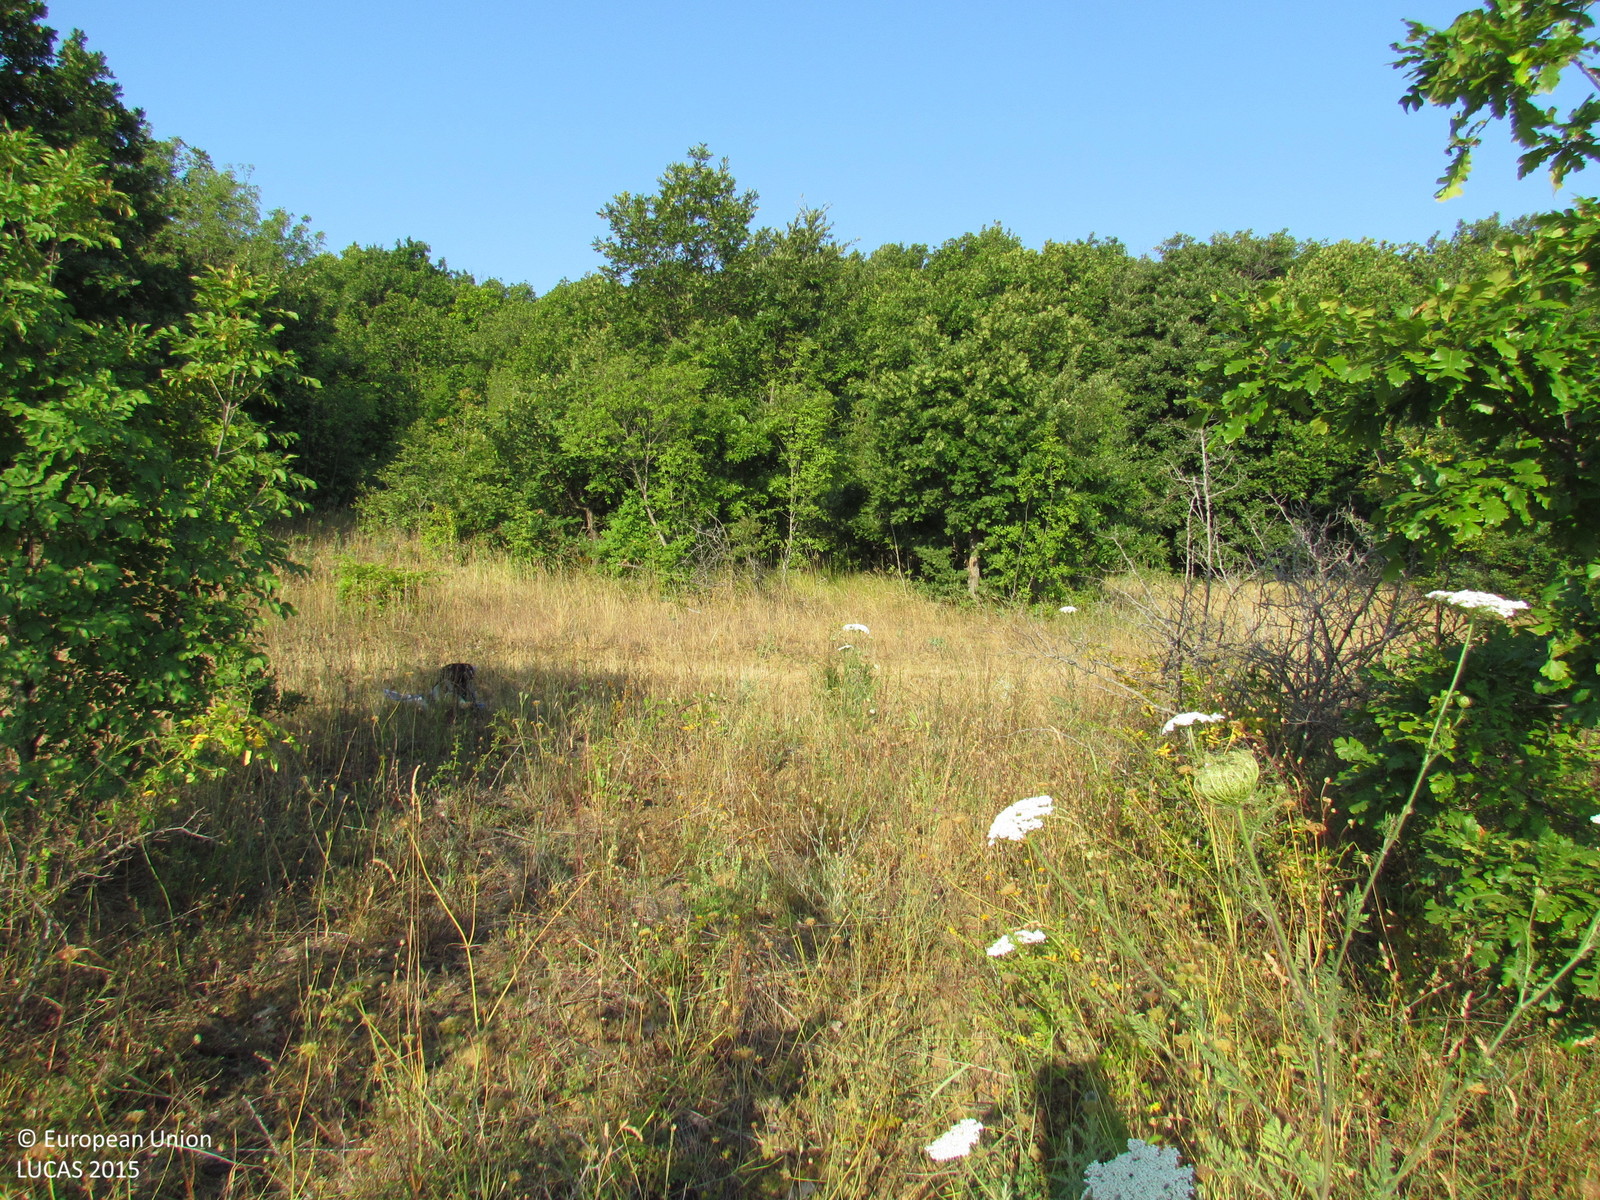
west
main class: Shrubland
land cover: Shrubland with sparse tree cover
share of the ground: 50 - 75 %
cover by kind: shrubs 55 %, herbaceous plants 40 %, broadleaved forest trees 5 %
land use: Semi-natural and natural areas not in use
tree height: < 5 m
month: July
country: BG
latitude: 42.7447
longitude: 27.8822
